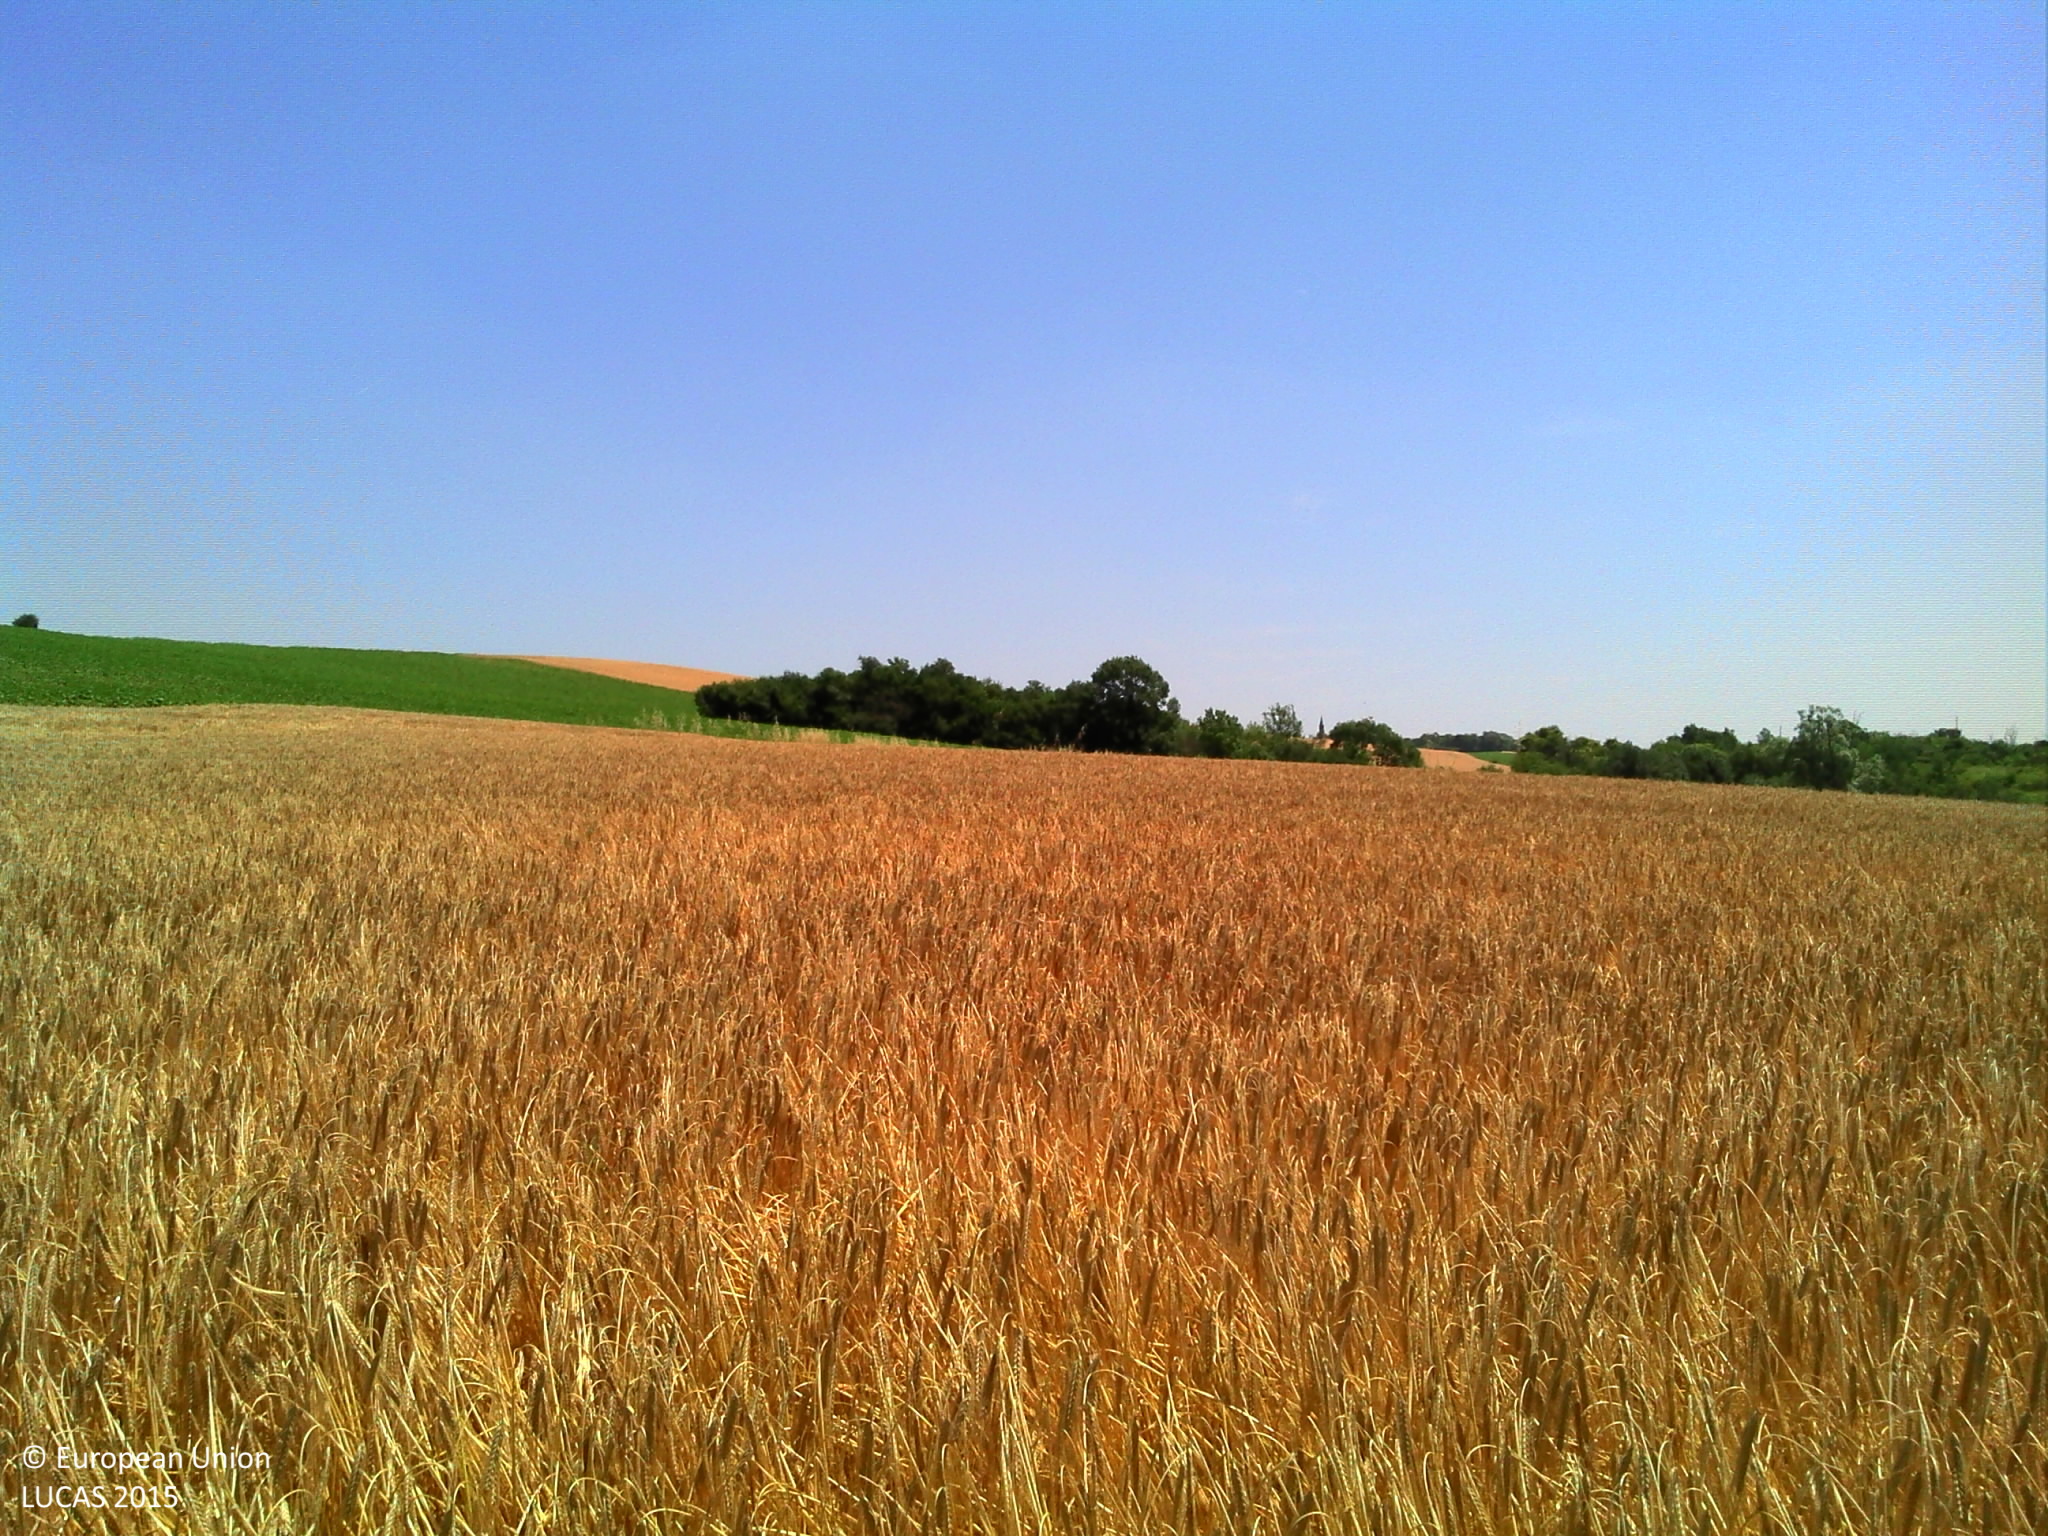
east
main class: Cropland
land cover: Barley
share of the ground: > 75 %
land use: Agriculture (excluding fallow land and kitchen gardens)
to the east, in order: Barley; Sunflower
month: June
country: FR
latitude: 43.7588
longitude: 0.9945
